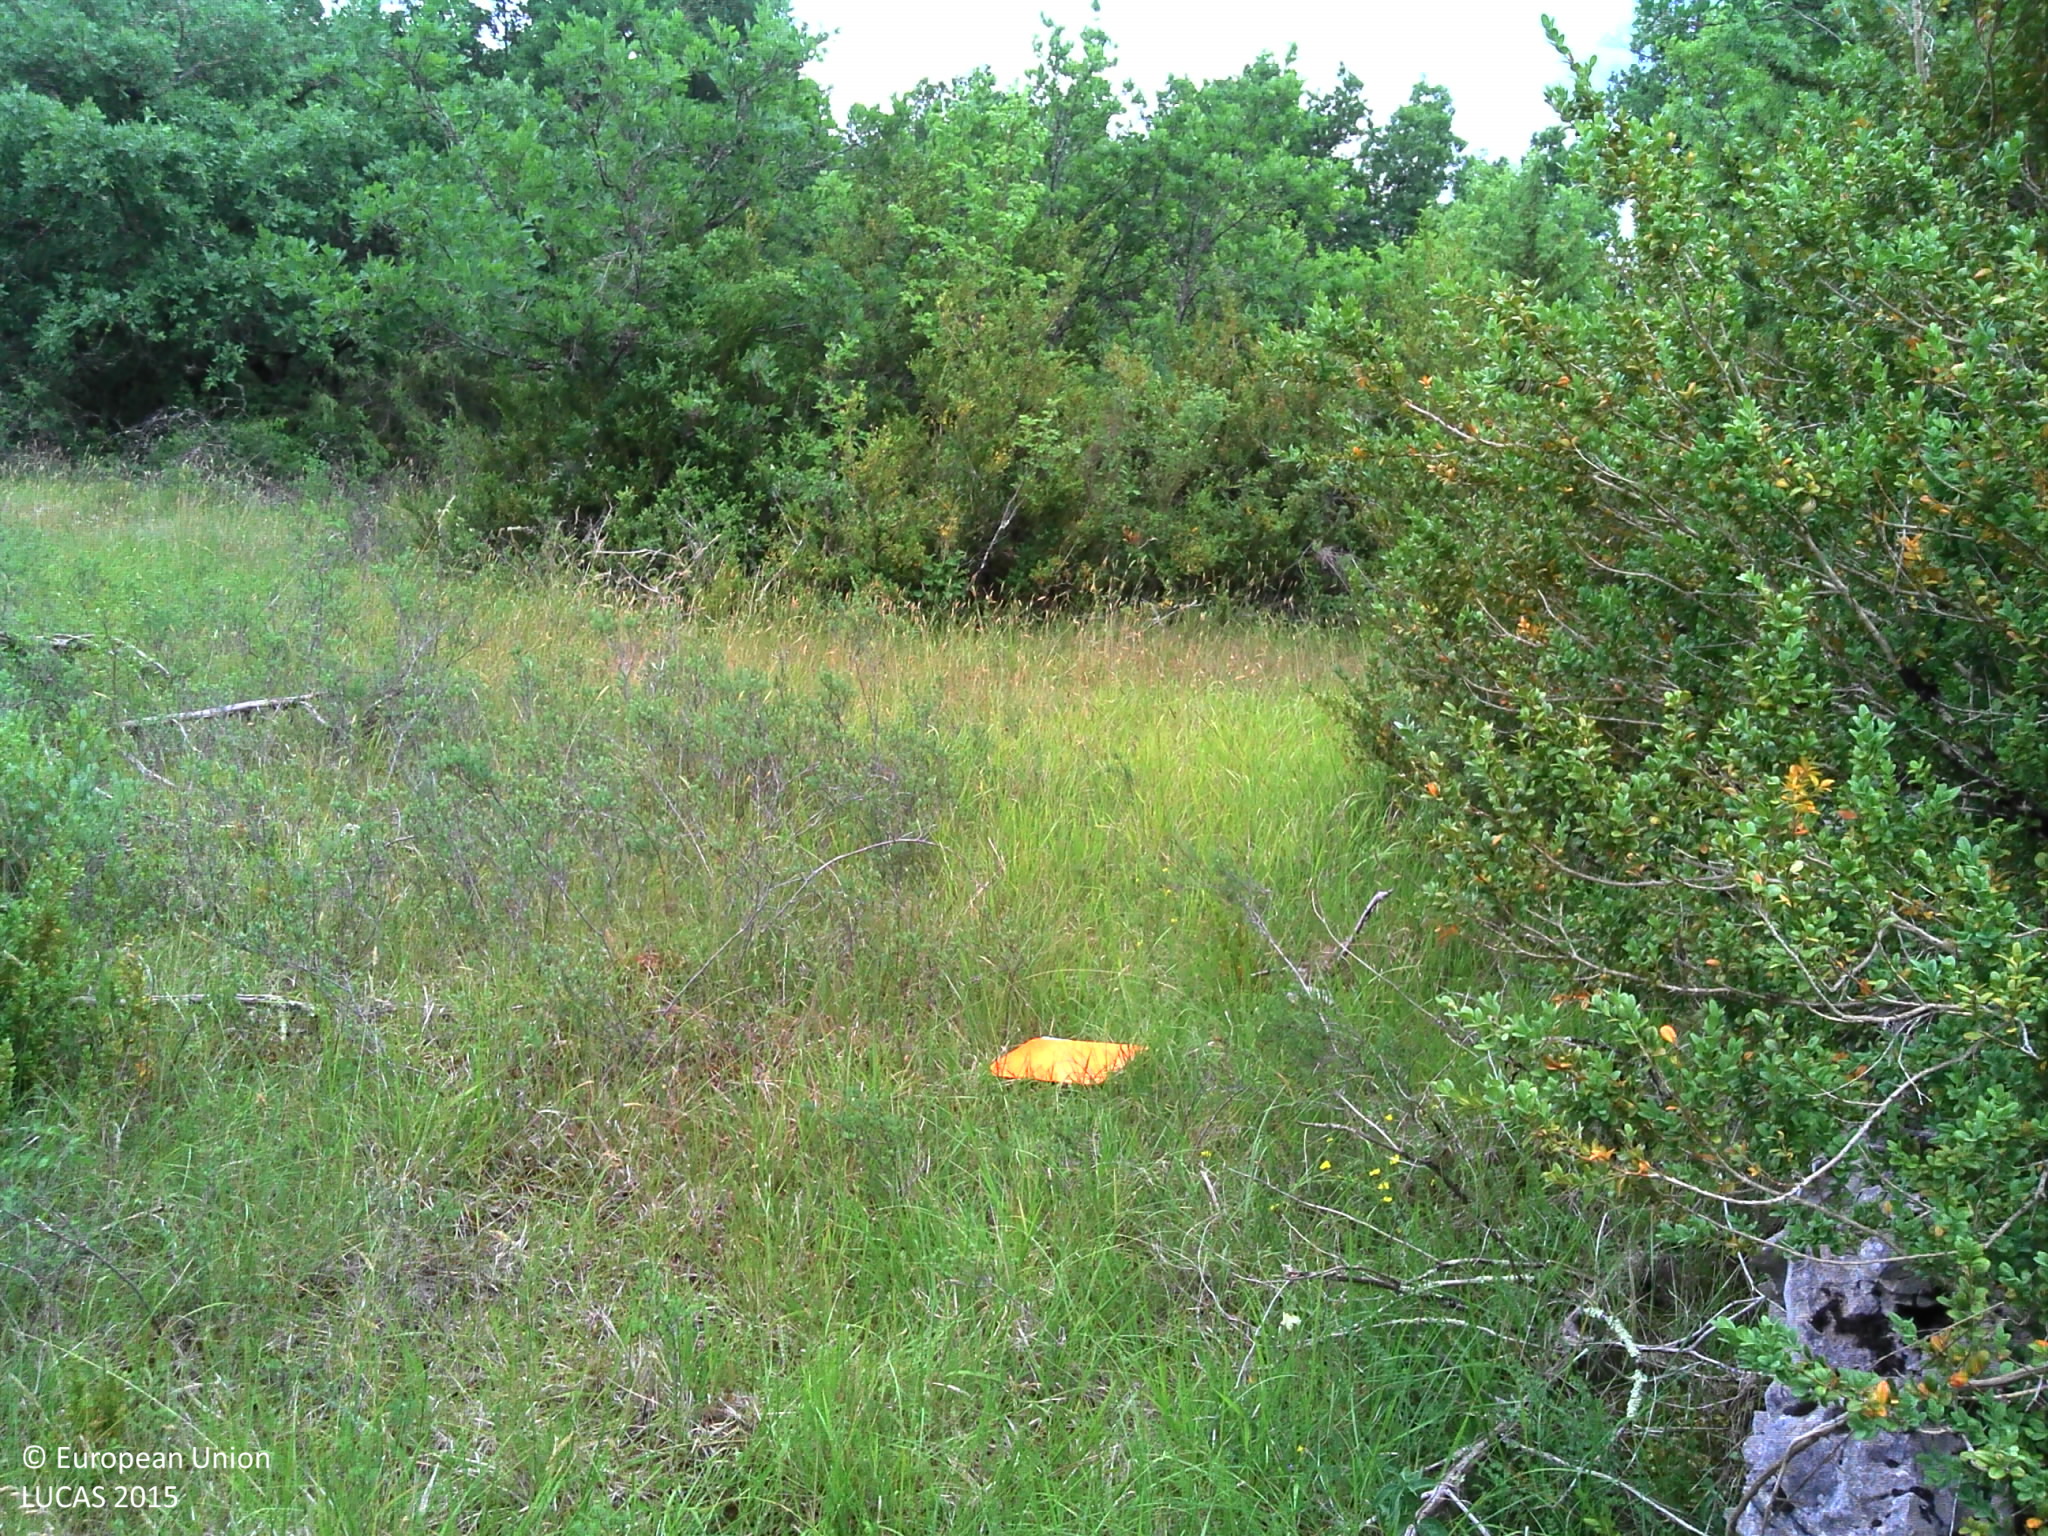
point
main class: Shrubland
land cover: Shrubland with sparse tree cover
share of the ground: > 75 %
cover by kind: shrubs 55 %, herbaceous plants 25 %, lichens and mosses 15 %, broadleaved forest trees 5 %
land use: Agriculture (excluding fallow land and kitchen gardens)
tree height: > 5 m
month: June
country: FR
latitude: 44.4678
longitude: 1.8926
